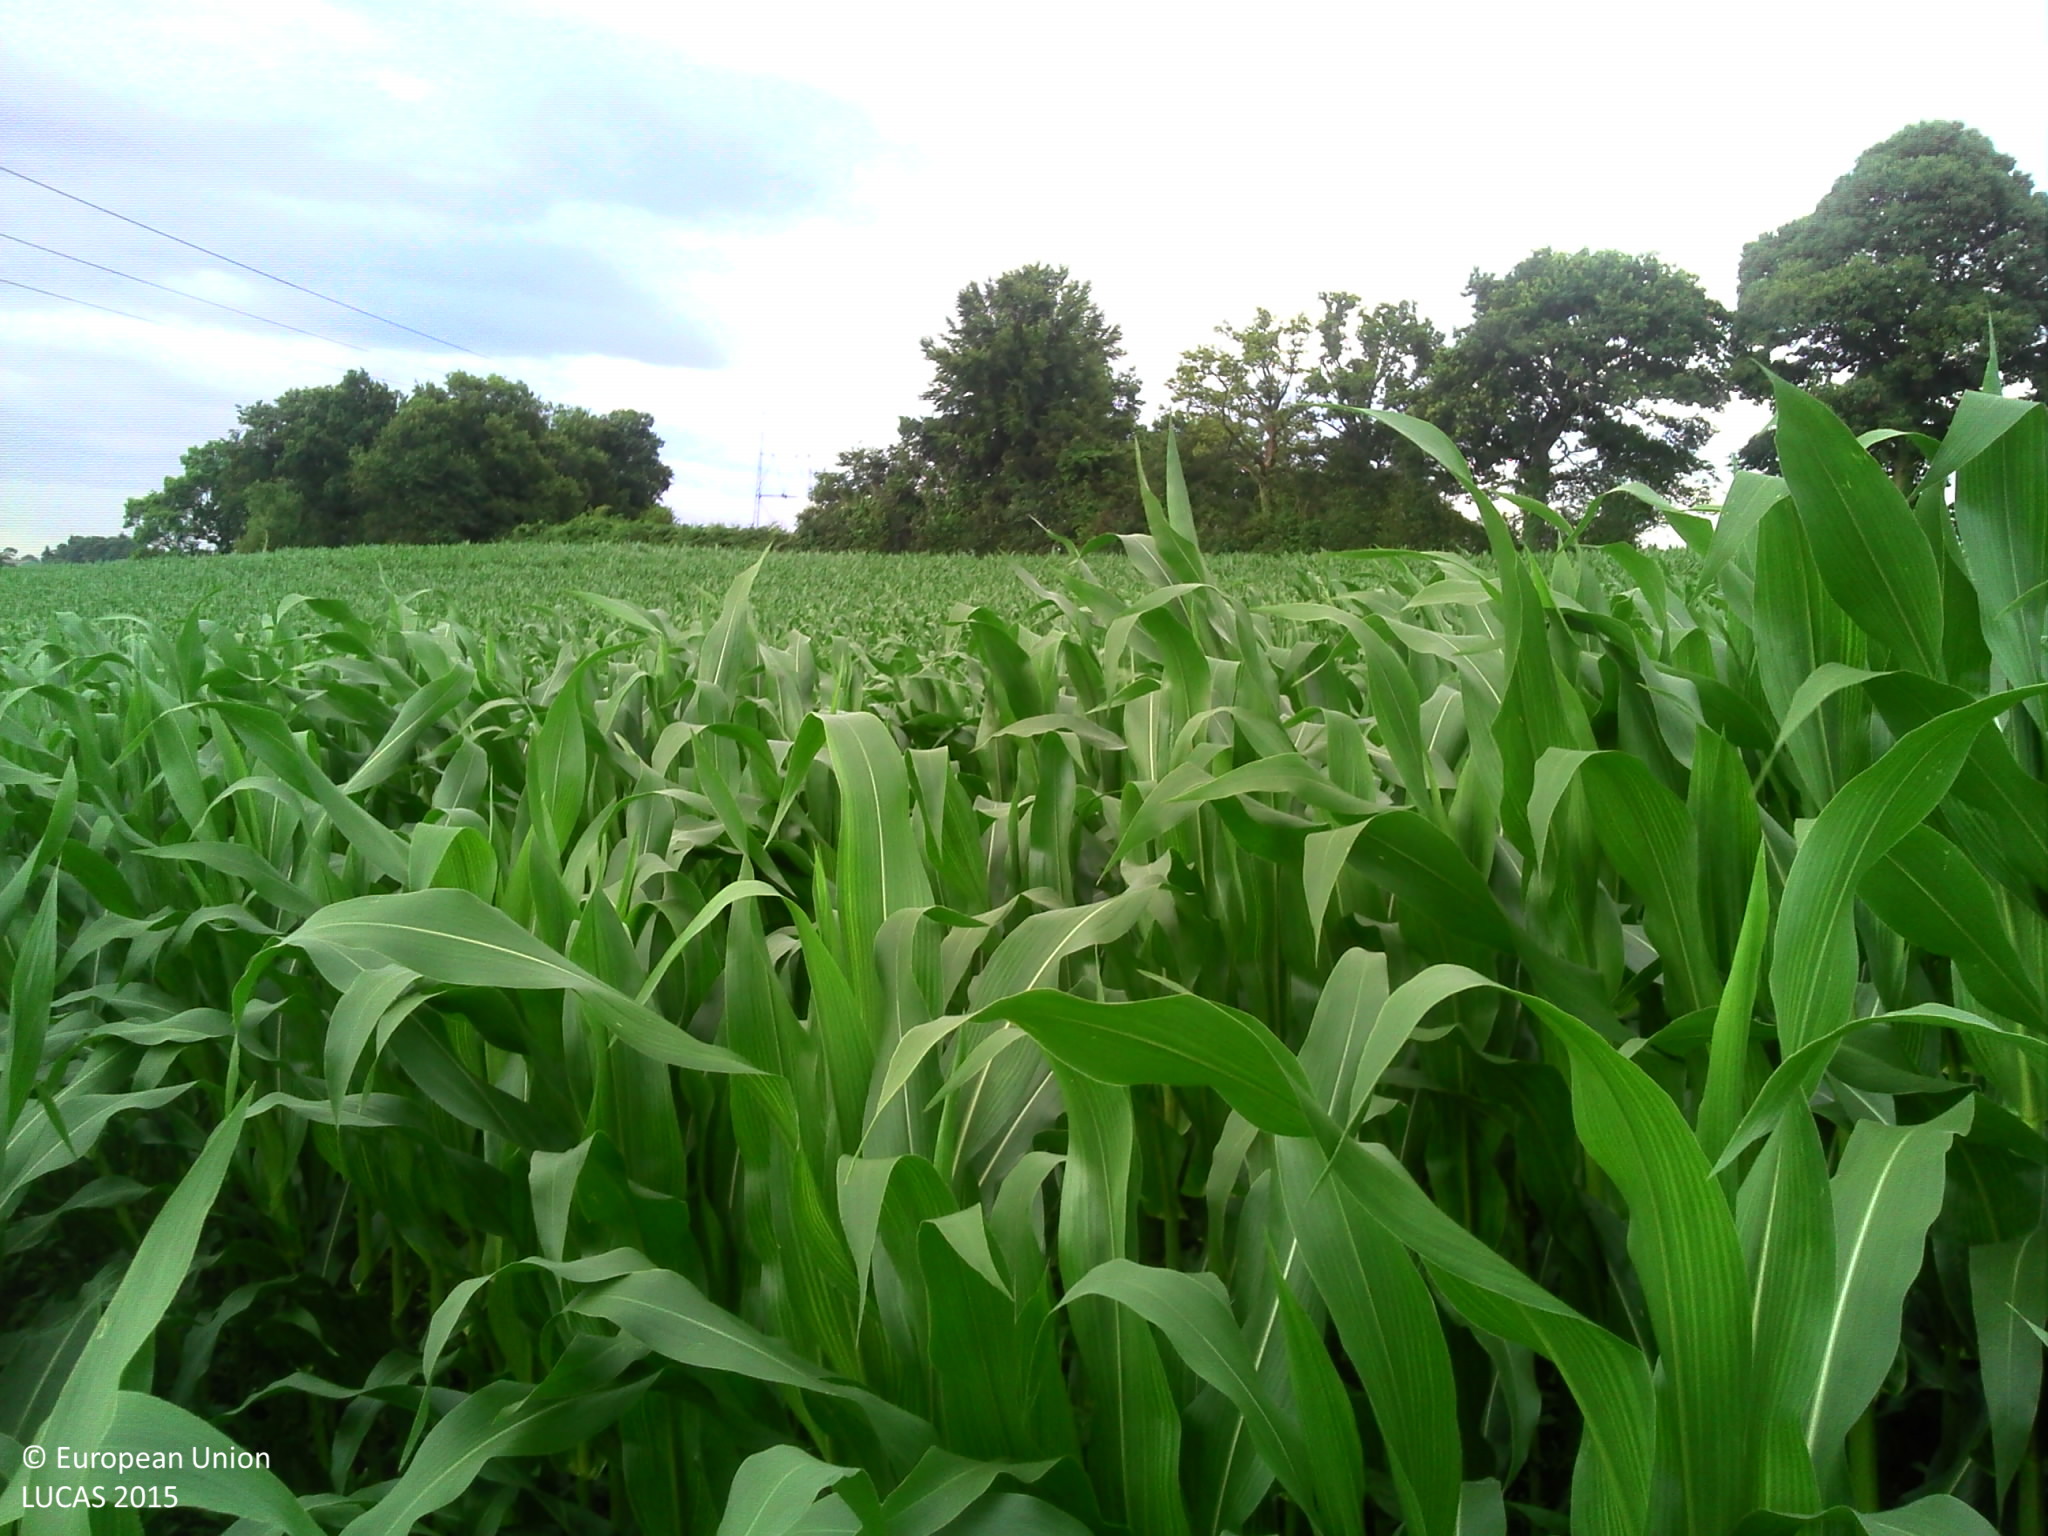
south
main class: Cropland
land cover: Maize
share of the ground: > 75 %
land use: Agriculture (excluding fallow land and kitchen gardens)
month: July
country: FR
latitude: 48.7726
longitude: -1.2429
